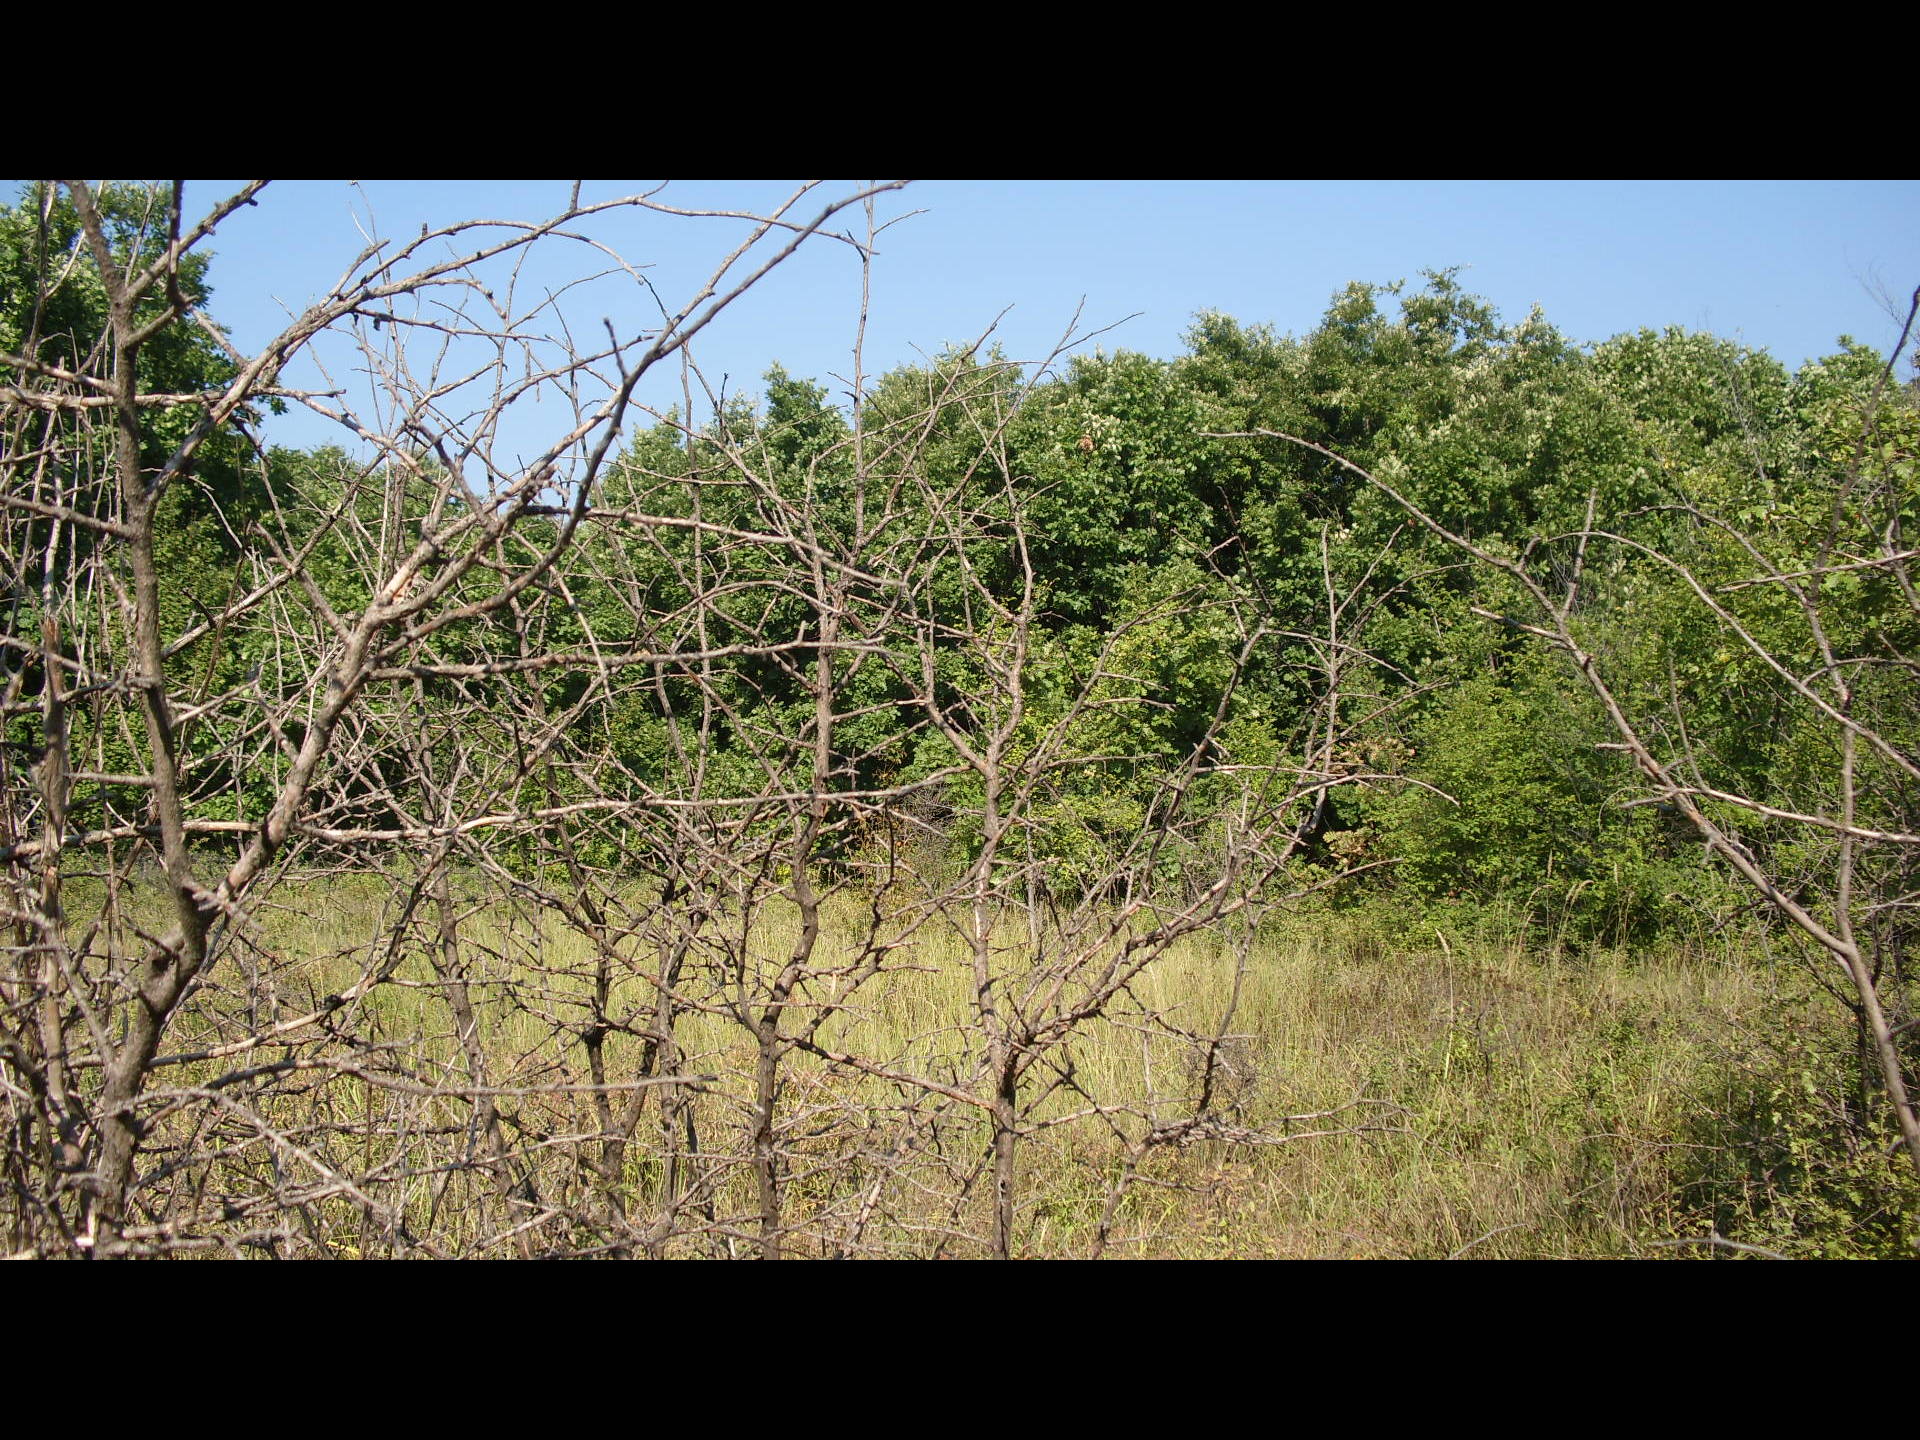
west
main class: Shrubland
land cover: Shrubland with sparse tree cover
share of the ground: > 75 %
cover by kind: shrubs 80 %, herbaceous plants 15 %, broadleaved forest trees 5 %
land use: Semi-natural and natural areas not in use
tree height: < 5 m
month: September
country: BG
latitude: 44.0556
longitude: 22.5810
